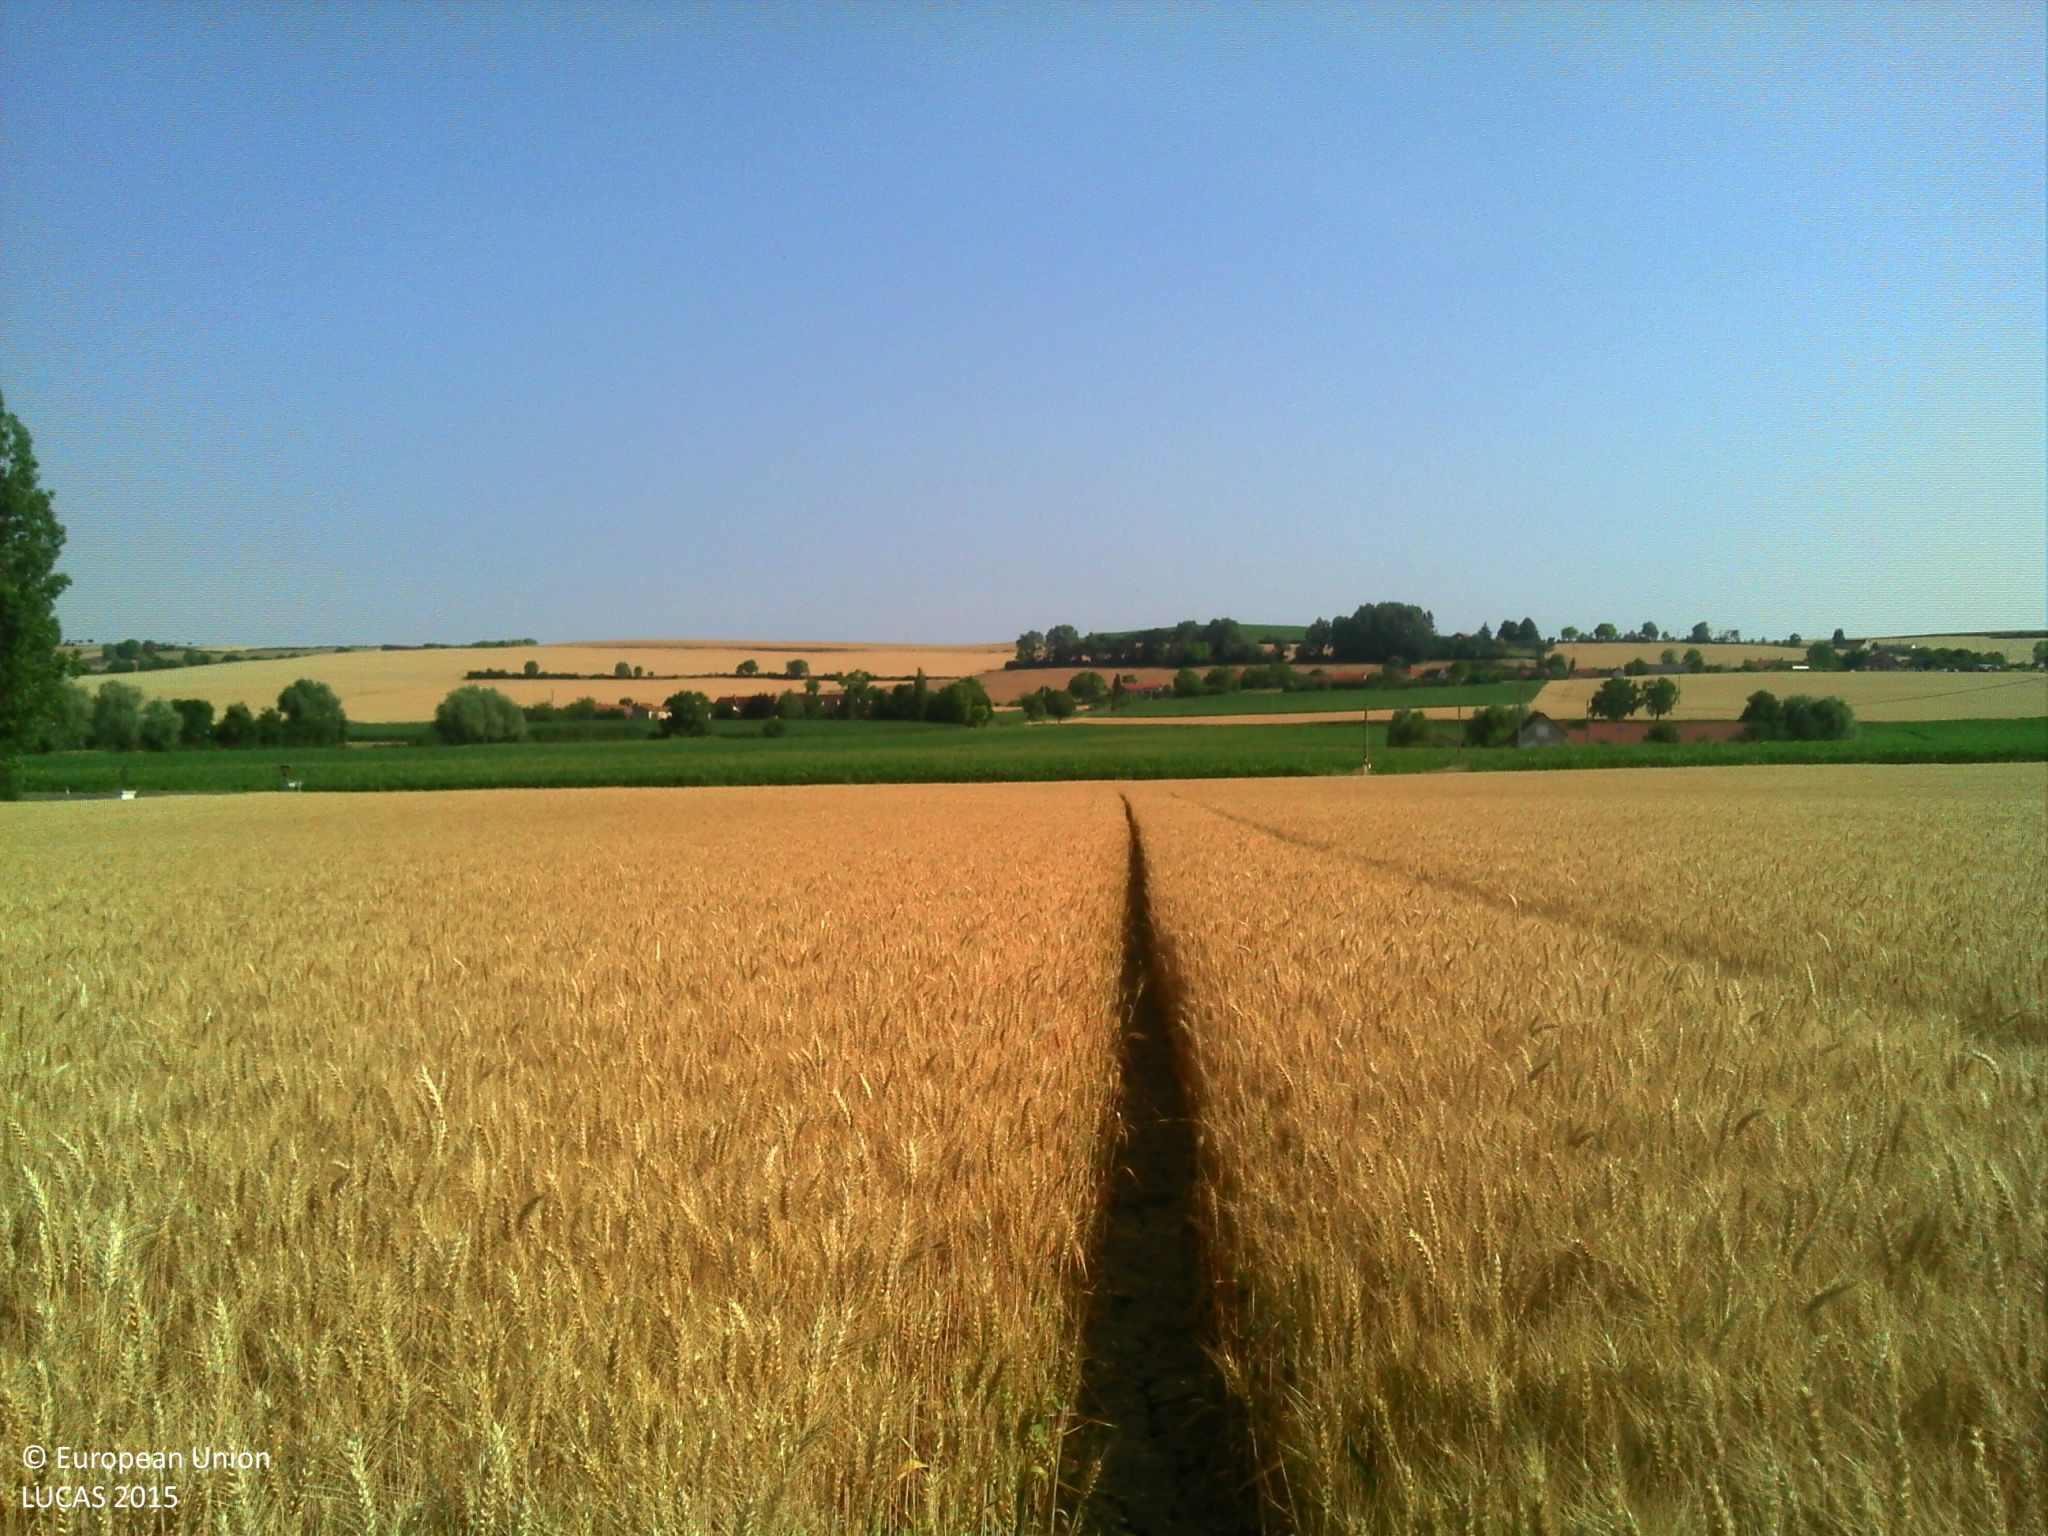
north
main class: Cropland
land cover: Common wheat
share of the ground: > 75 %
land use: Agriculture (excluding fallow land and kitchen gardens)
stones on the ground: < 10 %
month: July
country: FR
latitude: 46.1462
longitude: 3.0980
